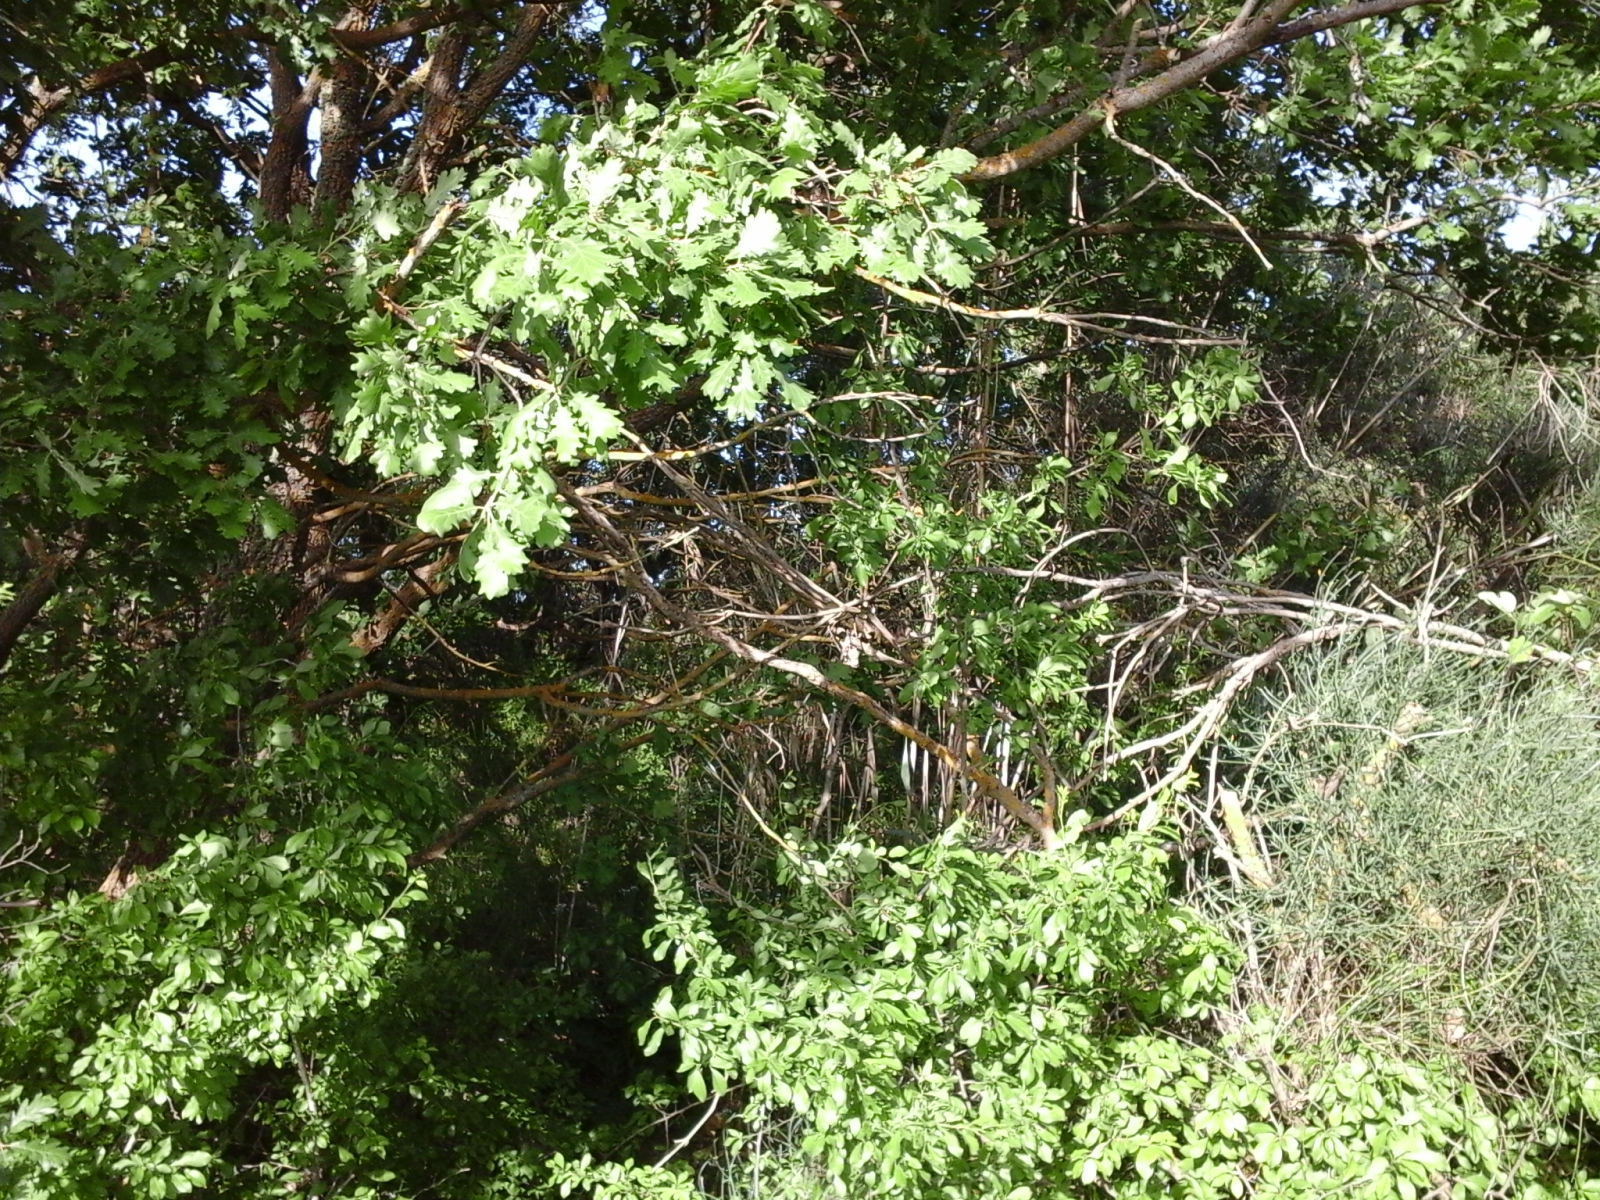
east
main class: Woodland
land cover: Broadleaved woodland
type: broadleaved evergreen forest
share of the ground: > 75 %
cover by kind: broadleaved forest trees 70 %, shrubs 20 %, coniferous forest trees 10 %
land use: Forestry
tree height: > 5 m
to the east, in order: Broadleaved woodland; Ditches and canals; Broadleaved woodland; Tracks; Grassland with sparse tree/shrub cover; Abandoned hedges; Other bare soil; Abandoned hedges; Fences; Other fruit trees and berries
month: May
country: IT
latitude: 37.4985
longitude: 14.0306
